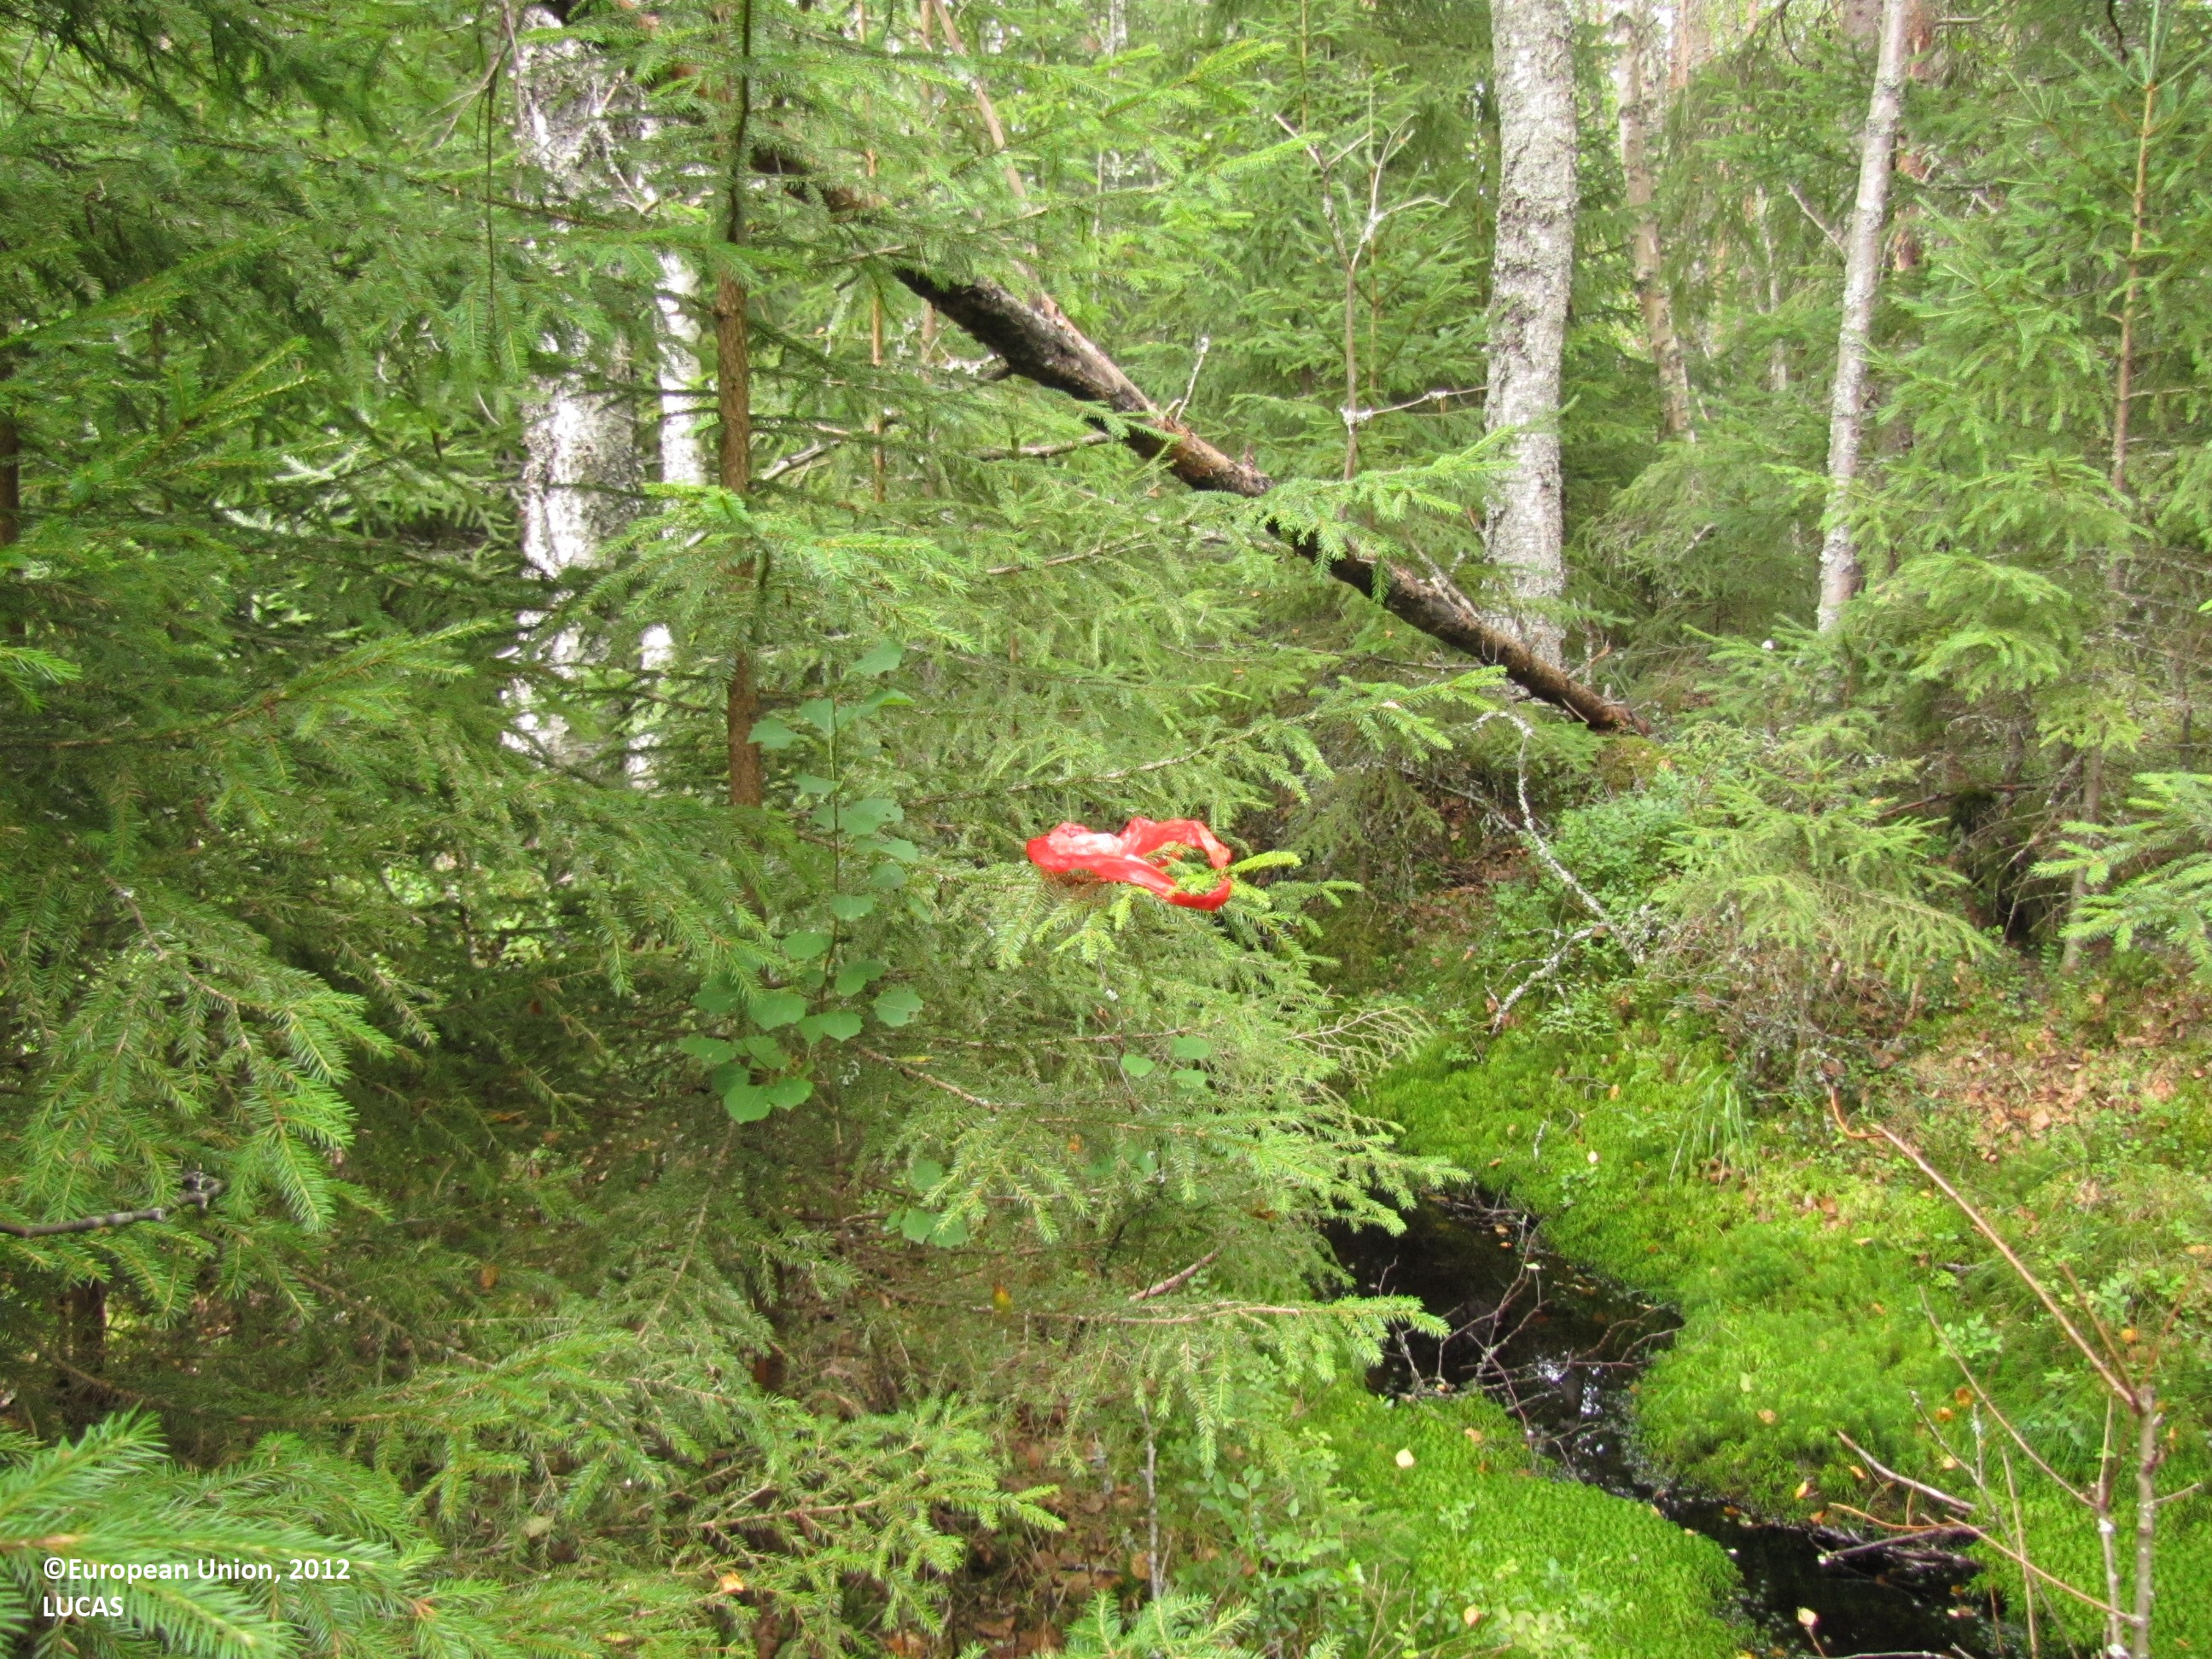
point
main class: Woodland
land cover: Pine dominated mixed woodland
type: boreal forest
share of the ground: 50 - 75 %
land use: Forestry
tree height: > 5 m
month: August
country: FI
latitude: 61.8978
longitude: 23.2213
